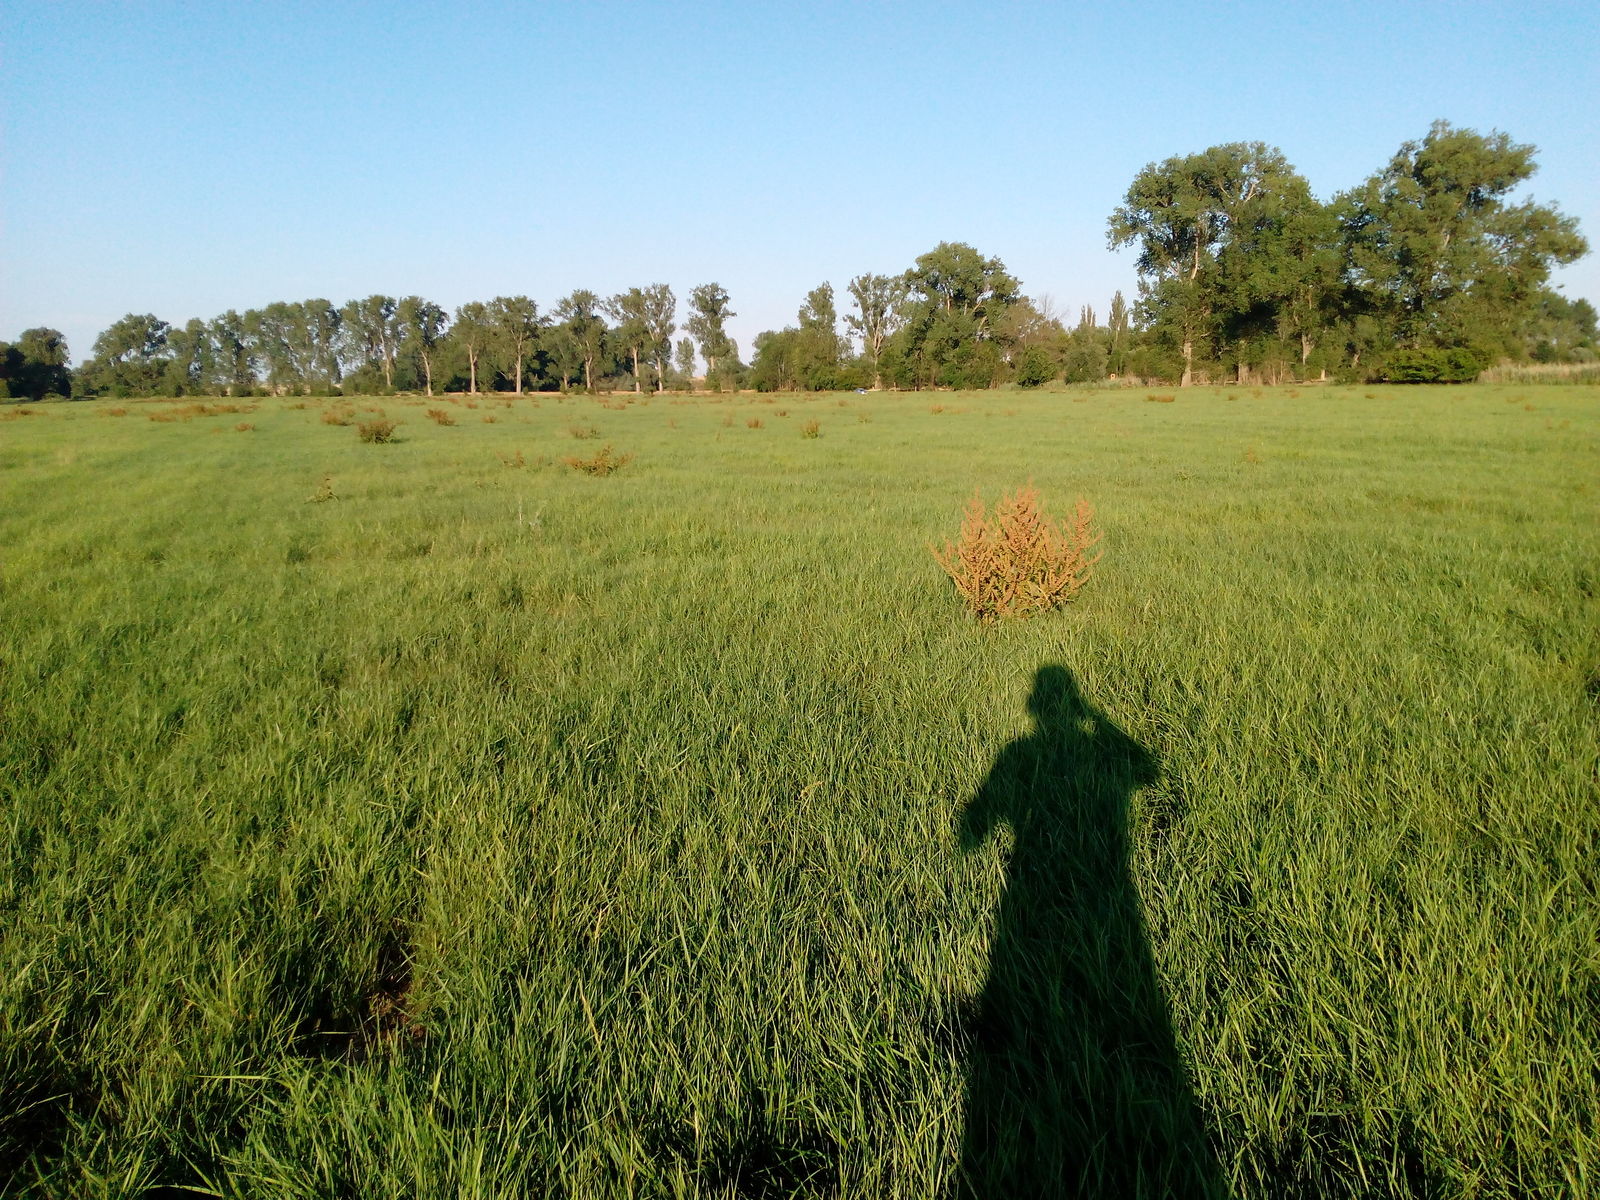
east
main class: Grassland
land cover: Grassland without tree/shrub cover
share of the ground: > 75 %
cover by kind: herbaceous plants 100 %
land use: Agriculture (excluding fallow land and kitchen gardens)
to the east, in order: Grassland without tree/shrub cover
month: July
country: DE
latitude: 51.1334
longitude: 10.9286
